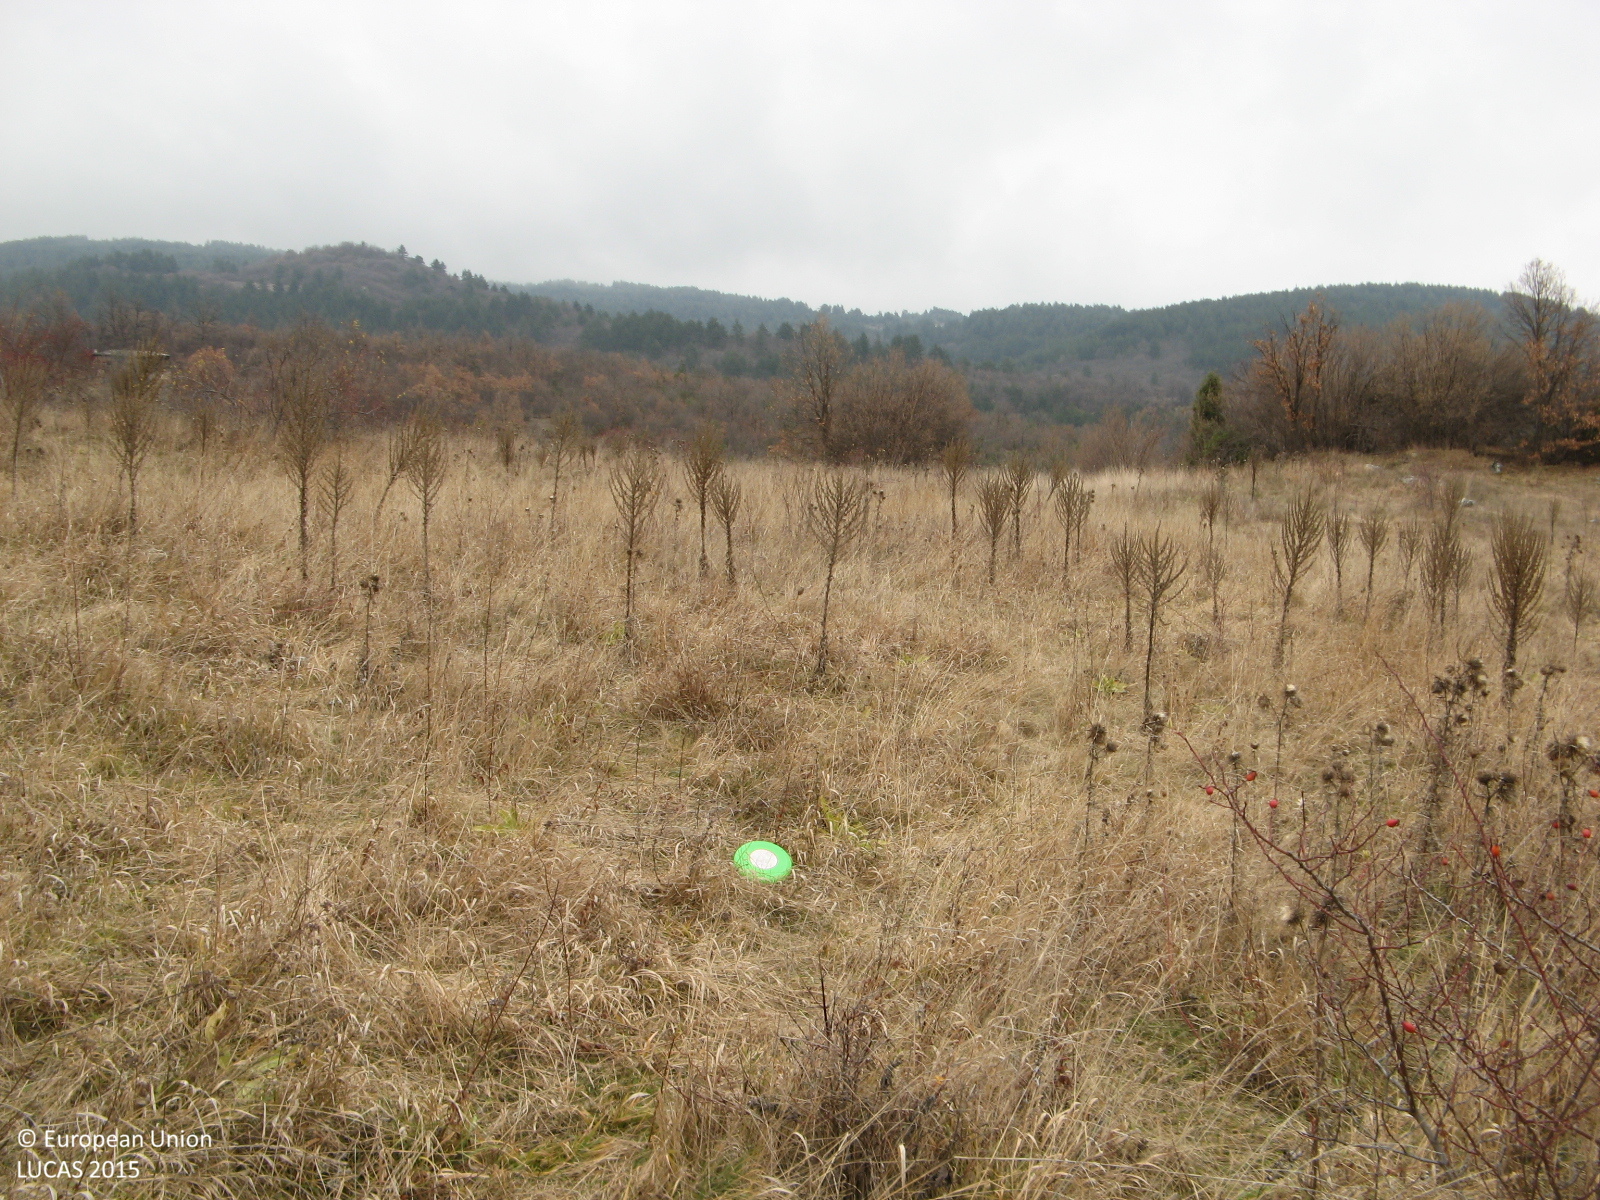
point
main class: Grassland
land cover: Grassland without tree/shrub cover
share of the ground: > 75 %
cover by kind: herbaceous plants 95 %, shrubs 5 %
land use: Agriculture (excluding fallow land and kitchen gardens)
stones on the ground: < 10 %
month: December
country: BG
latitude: 41.8771
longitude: 24.6384
